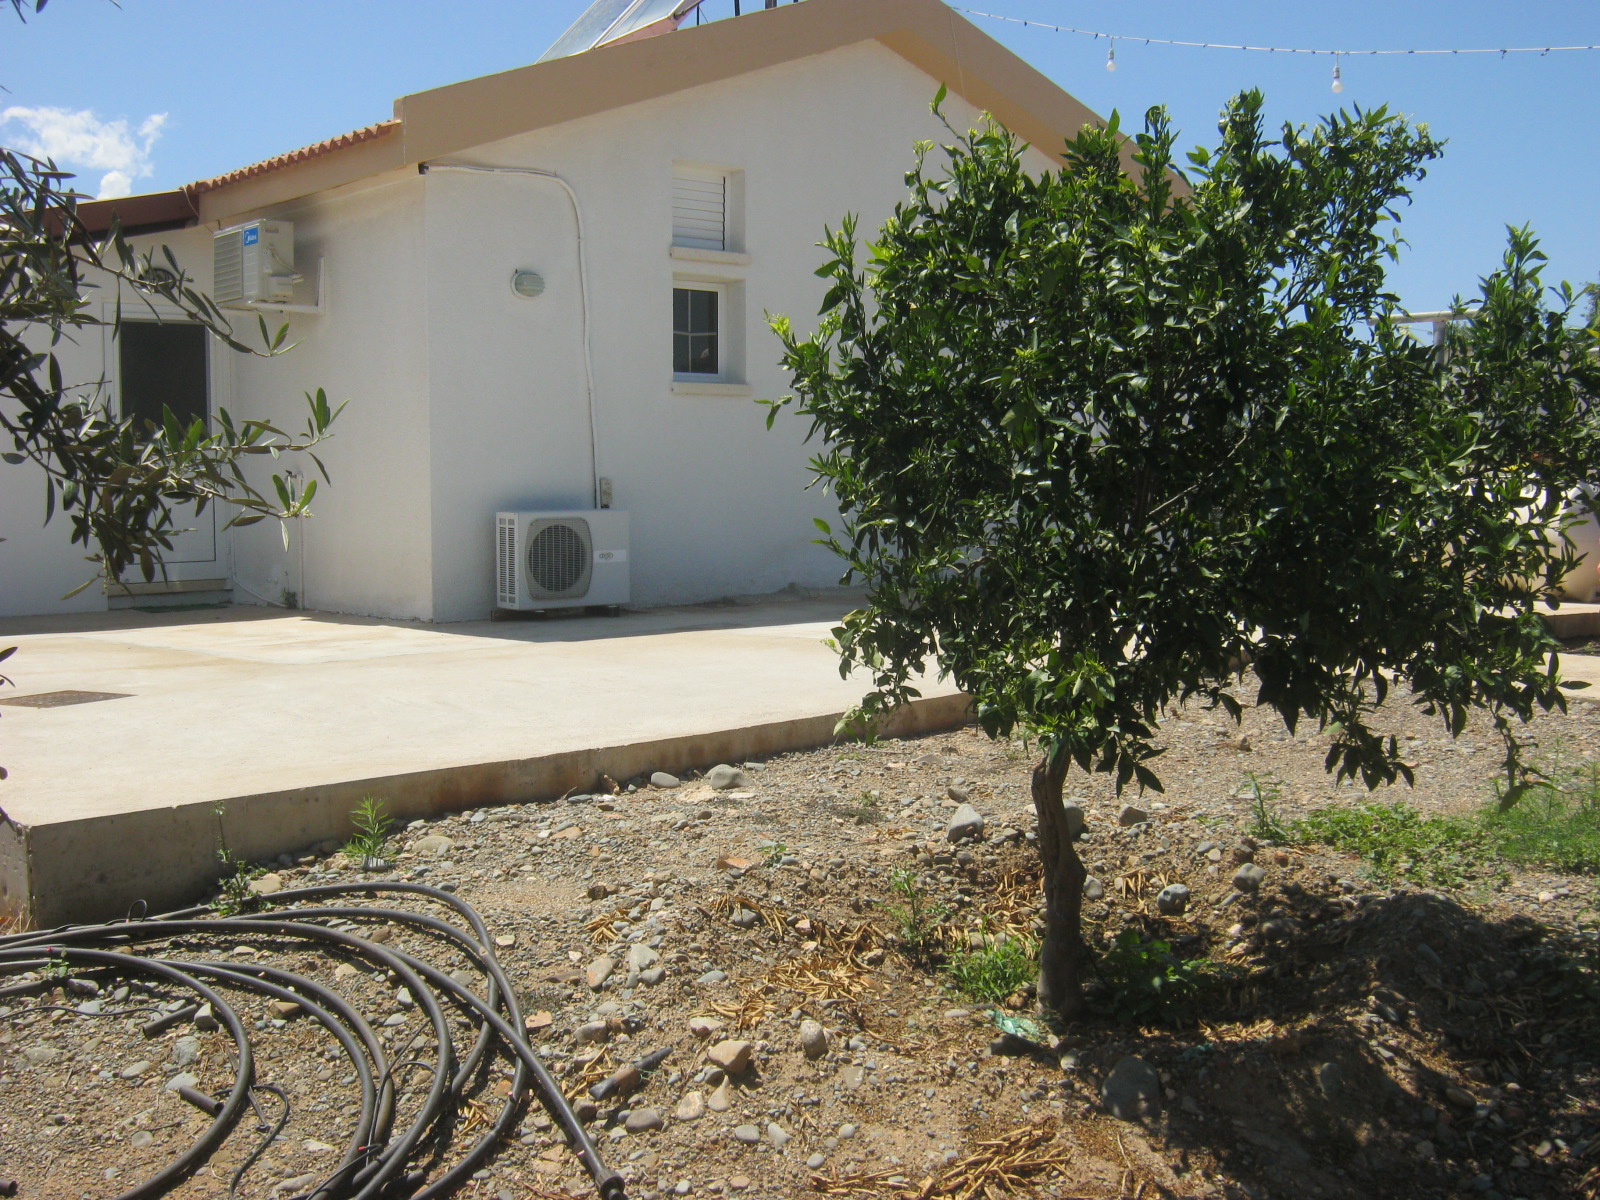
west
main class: Cropland
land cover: Olive groves
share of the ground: > 75 %
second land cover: Other bare soil
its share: > 75 %
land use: Kitchen garden
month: May
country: CY
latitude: 35.1395
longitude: 33.0420
